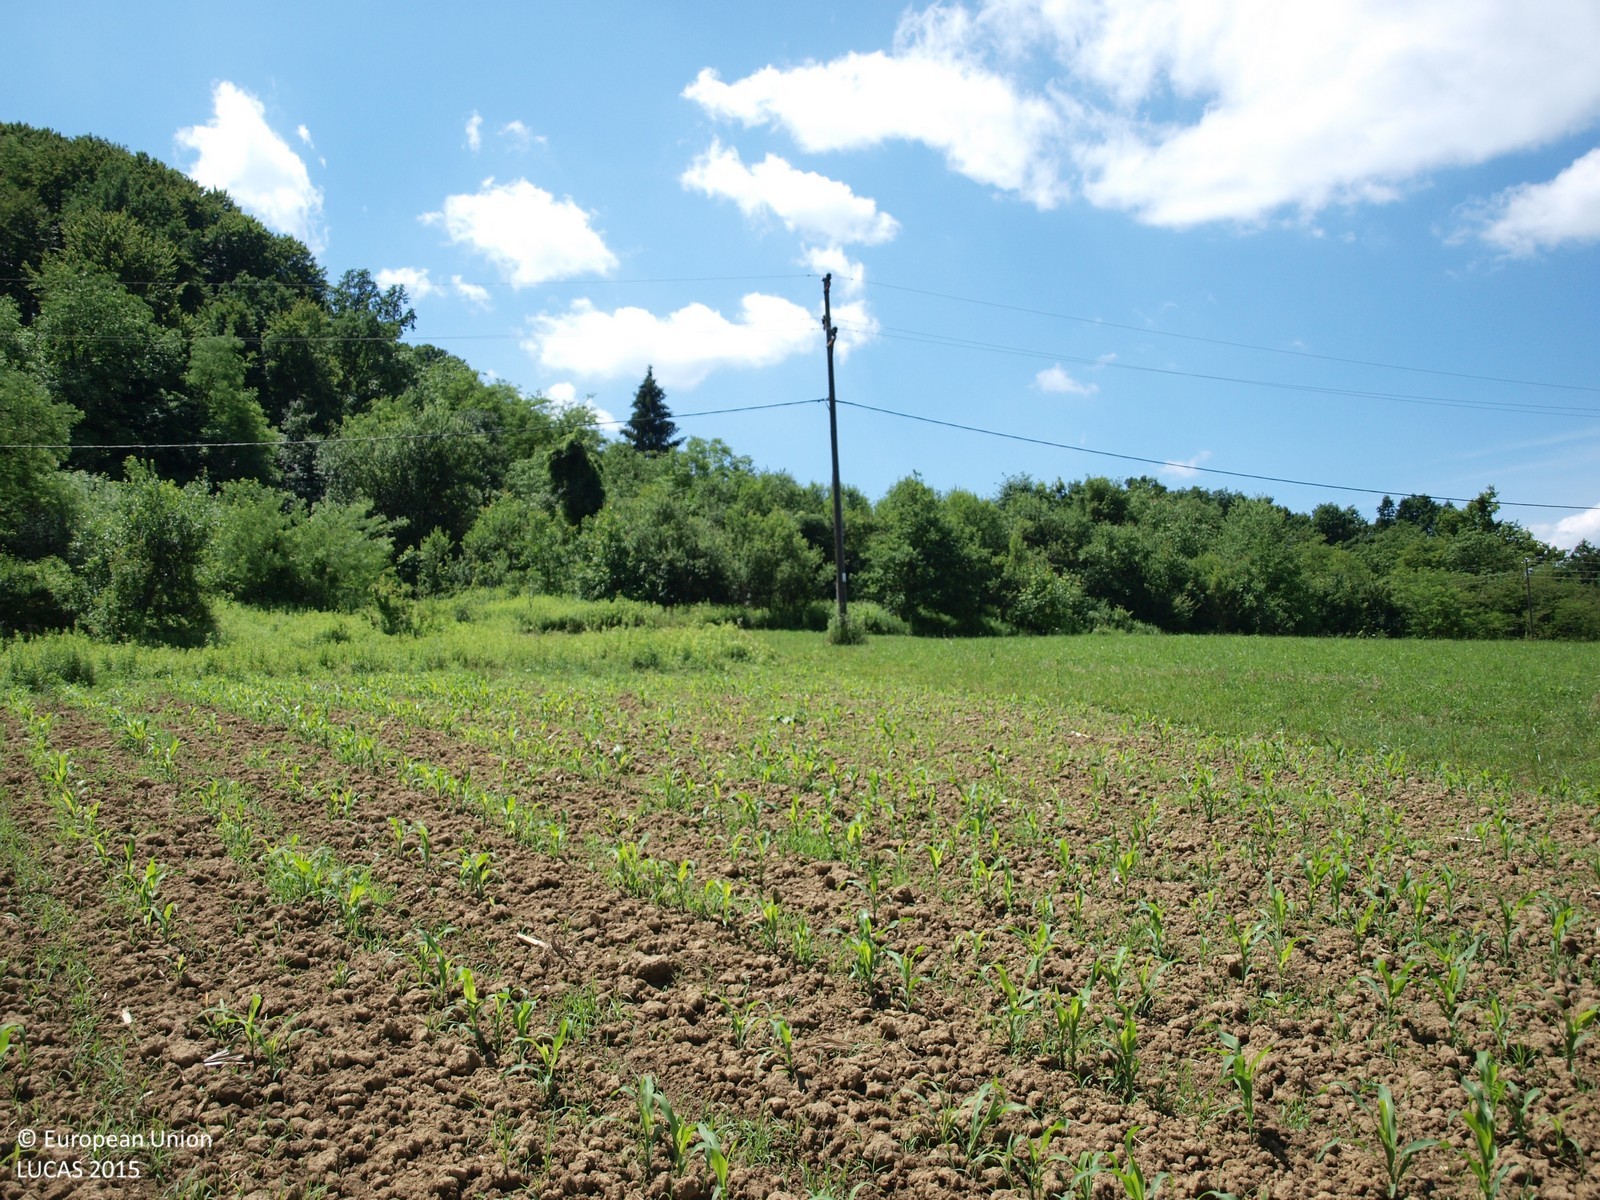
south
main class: Cropland
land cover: Maize
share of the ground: 25 - 50 %
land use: Agriculture (excluding fallow land and kitchen gardens)
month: June
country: HR
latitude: 46.0908
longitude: 15.7018
